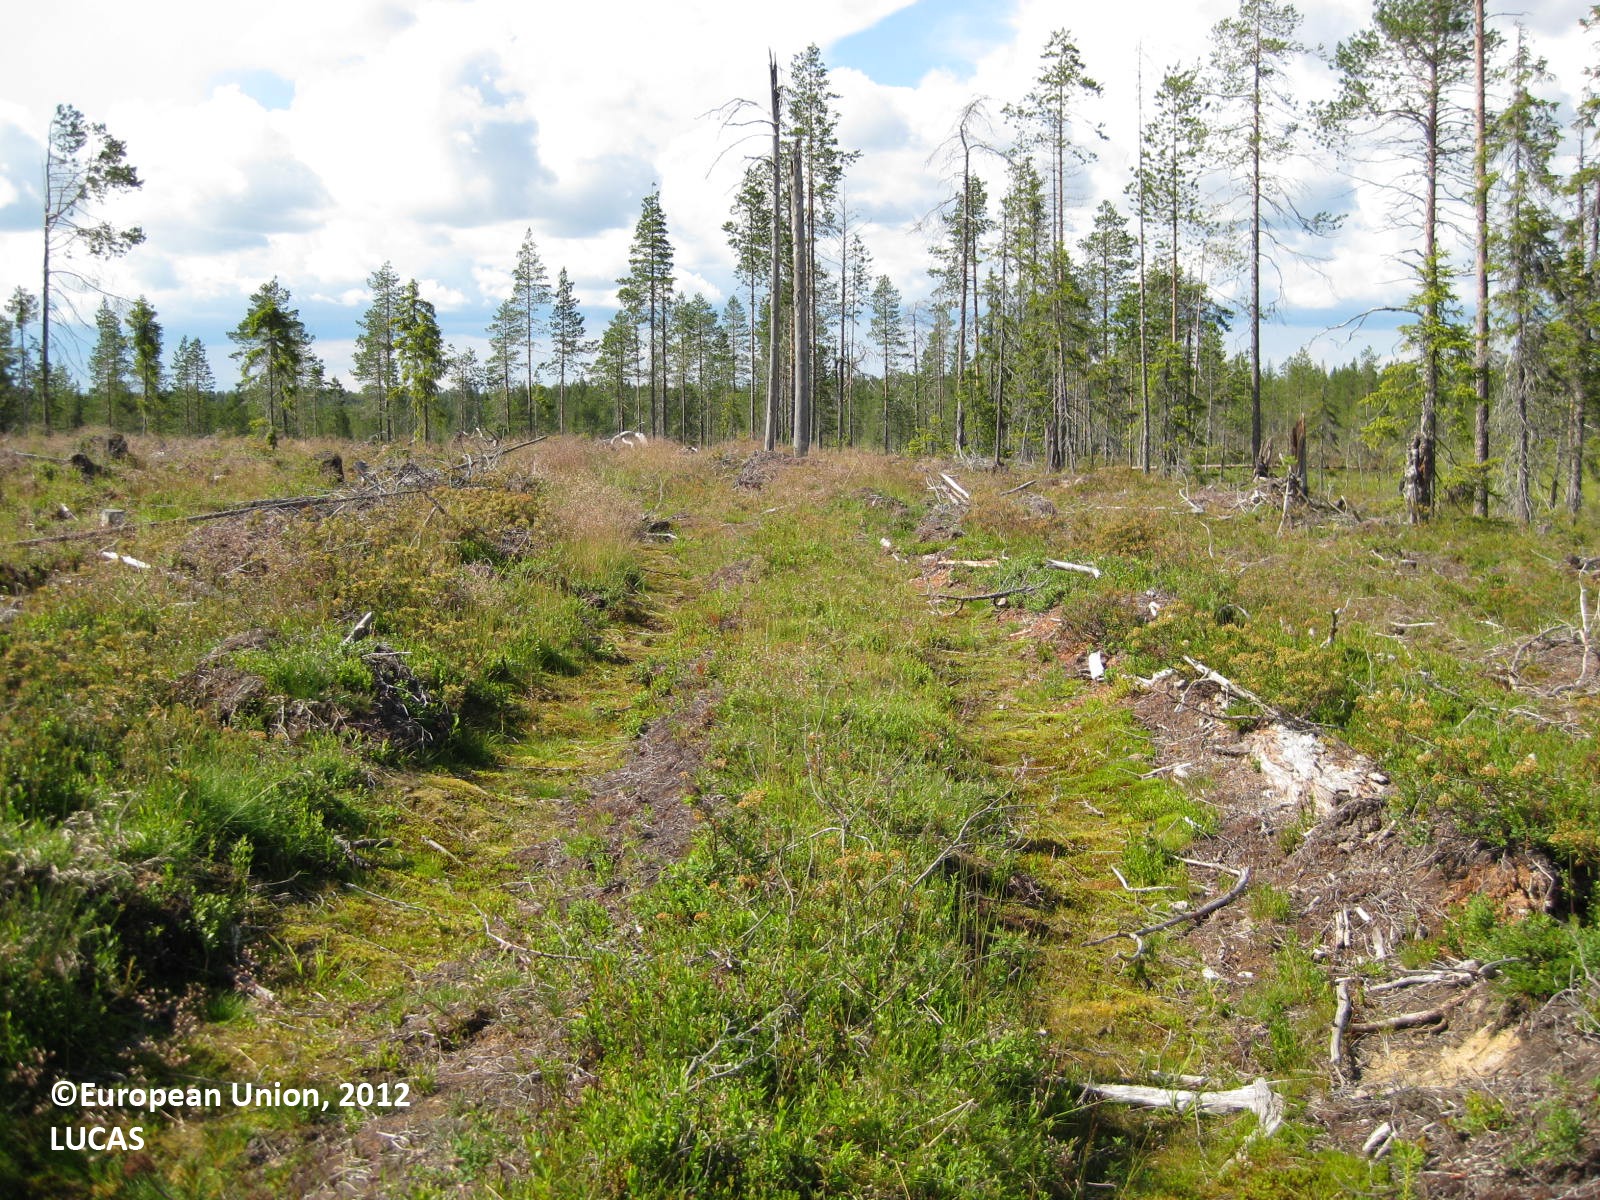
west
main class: Shrubland
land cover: Shrubland with sparse tree cover
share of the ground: > 75 %
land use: Forestry
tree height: < 5 m
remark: Clear cut
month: July
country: FI
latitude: 65.7979
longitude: 29.6329
